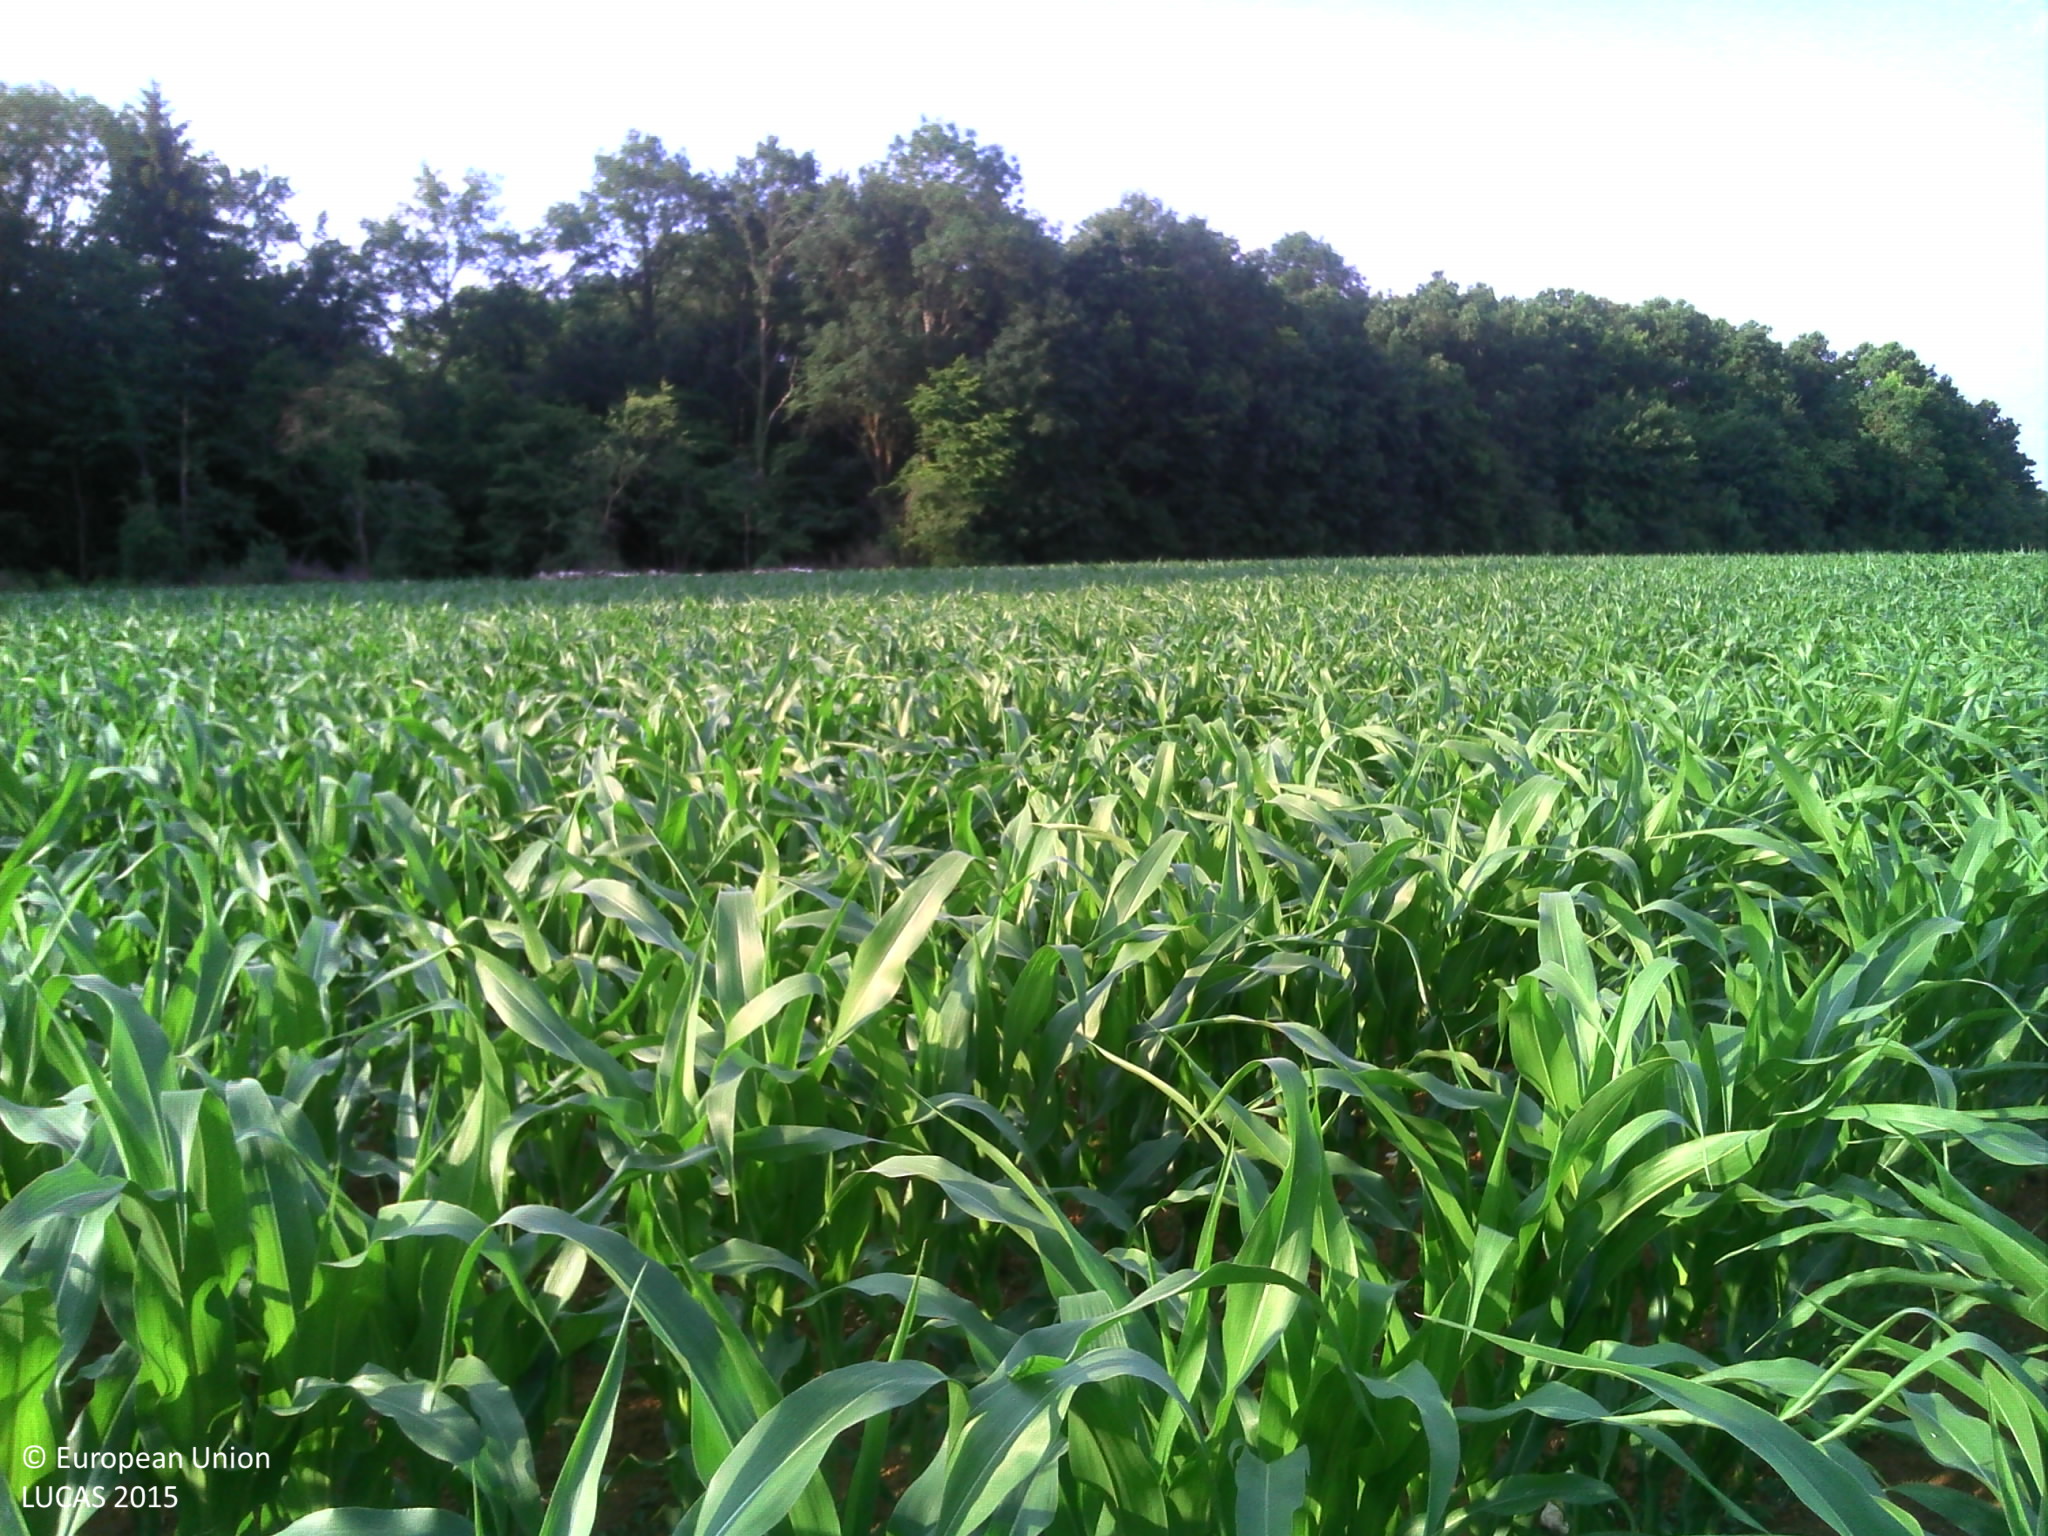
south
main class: Cropland
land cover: Maize
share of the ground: 25 - 50 %
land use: Agriculture (excluding fallow land and kitchen gardens)
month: July
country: FR
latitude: 48.8013
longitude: 5.1379
